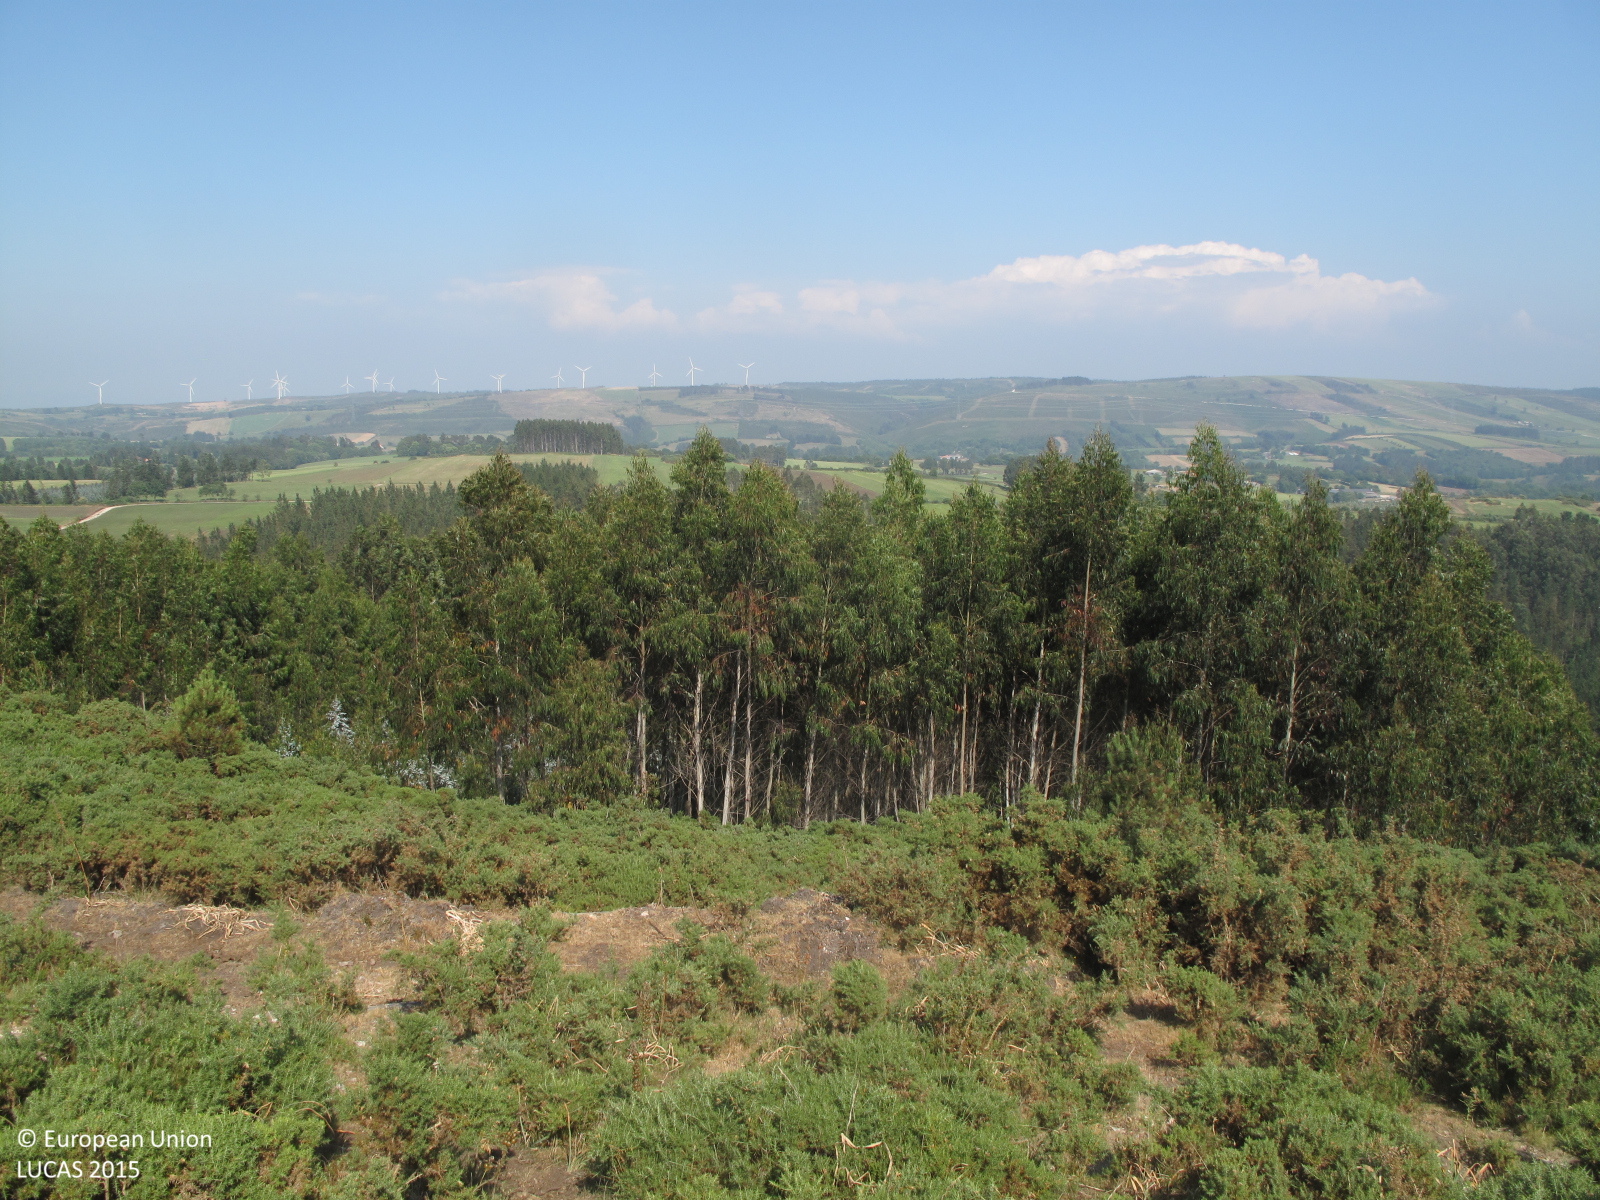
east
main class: Shrubland
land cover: Shrubland without tree cover
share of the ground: > 75 %
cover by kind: shrubs 80 %, herbaceous plants 10 %, unconsolidated bare surface 10 %
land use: Abandoned areas
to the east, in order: Shrubland without tree cover; Tracks; Shrubland without tree cover; Broadleaved woodland; Pine dominated coniferous woodland; Broadleaved woodland; Grassland without tree/shrub cover
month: June
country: ES
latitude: 43.2600
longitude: -7.9921
